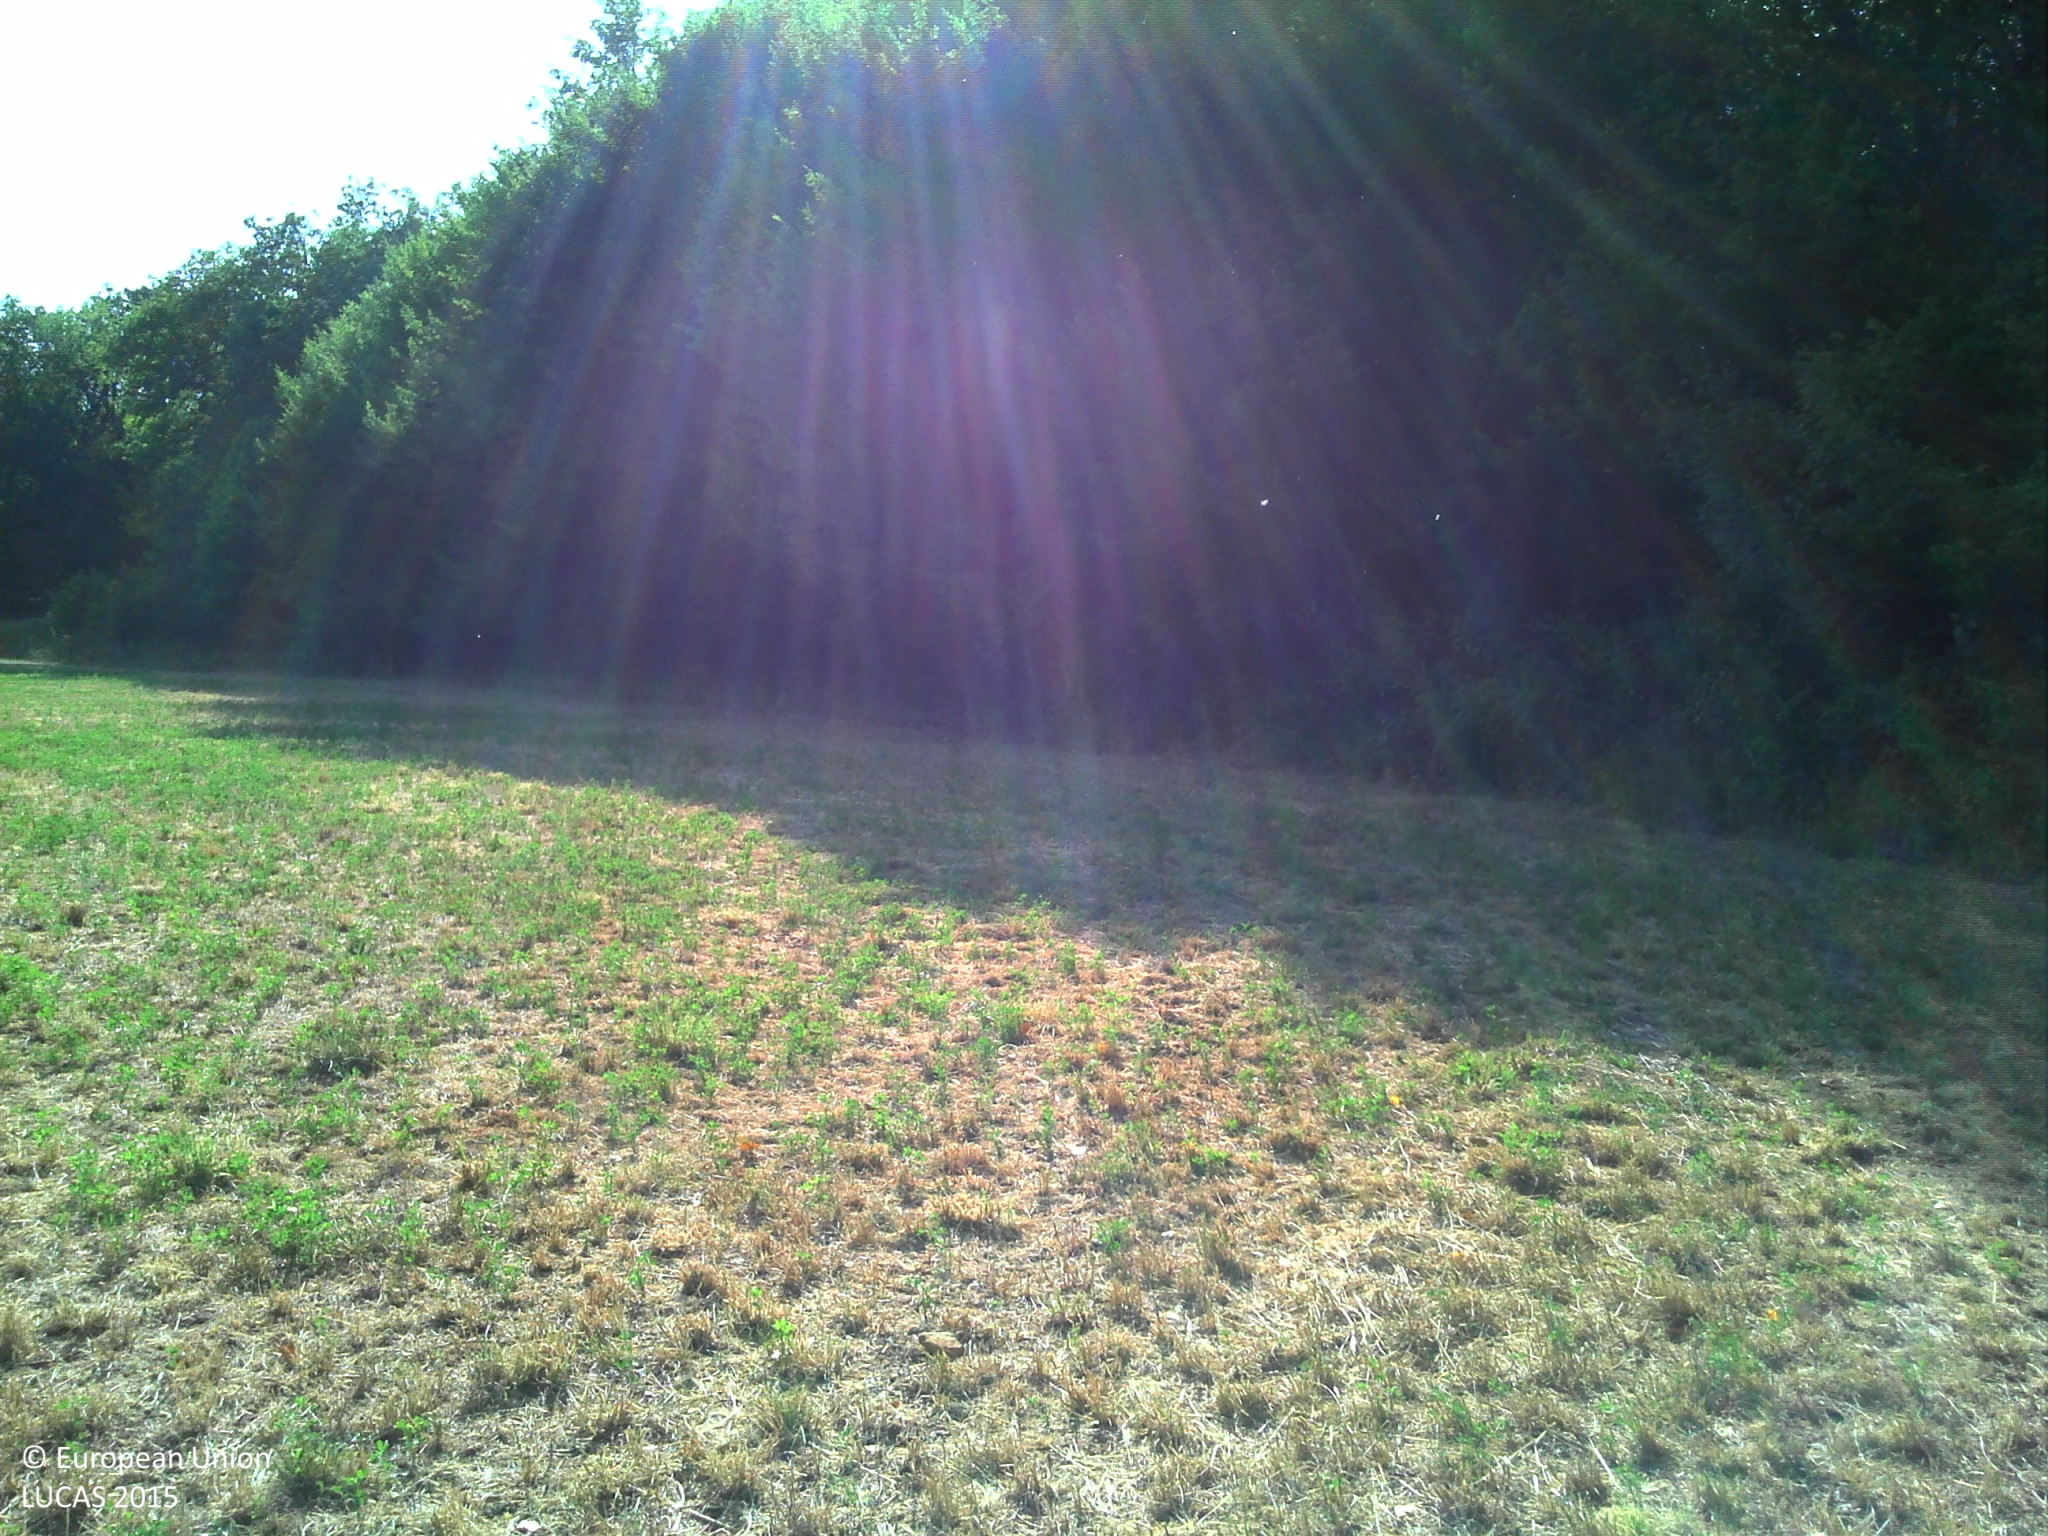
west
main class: Cropland
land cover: Temporary grasslands
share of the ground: > 75 %
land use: Agriculture (excluding fallow land and kitchen gardens)
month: July
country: FR
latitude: 45.2378
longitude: 1.1136
